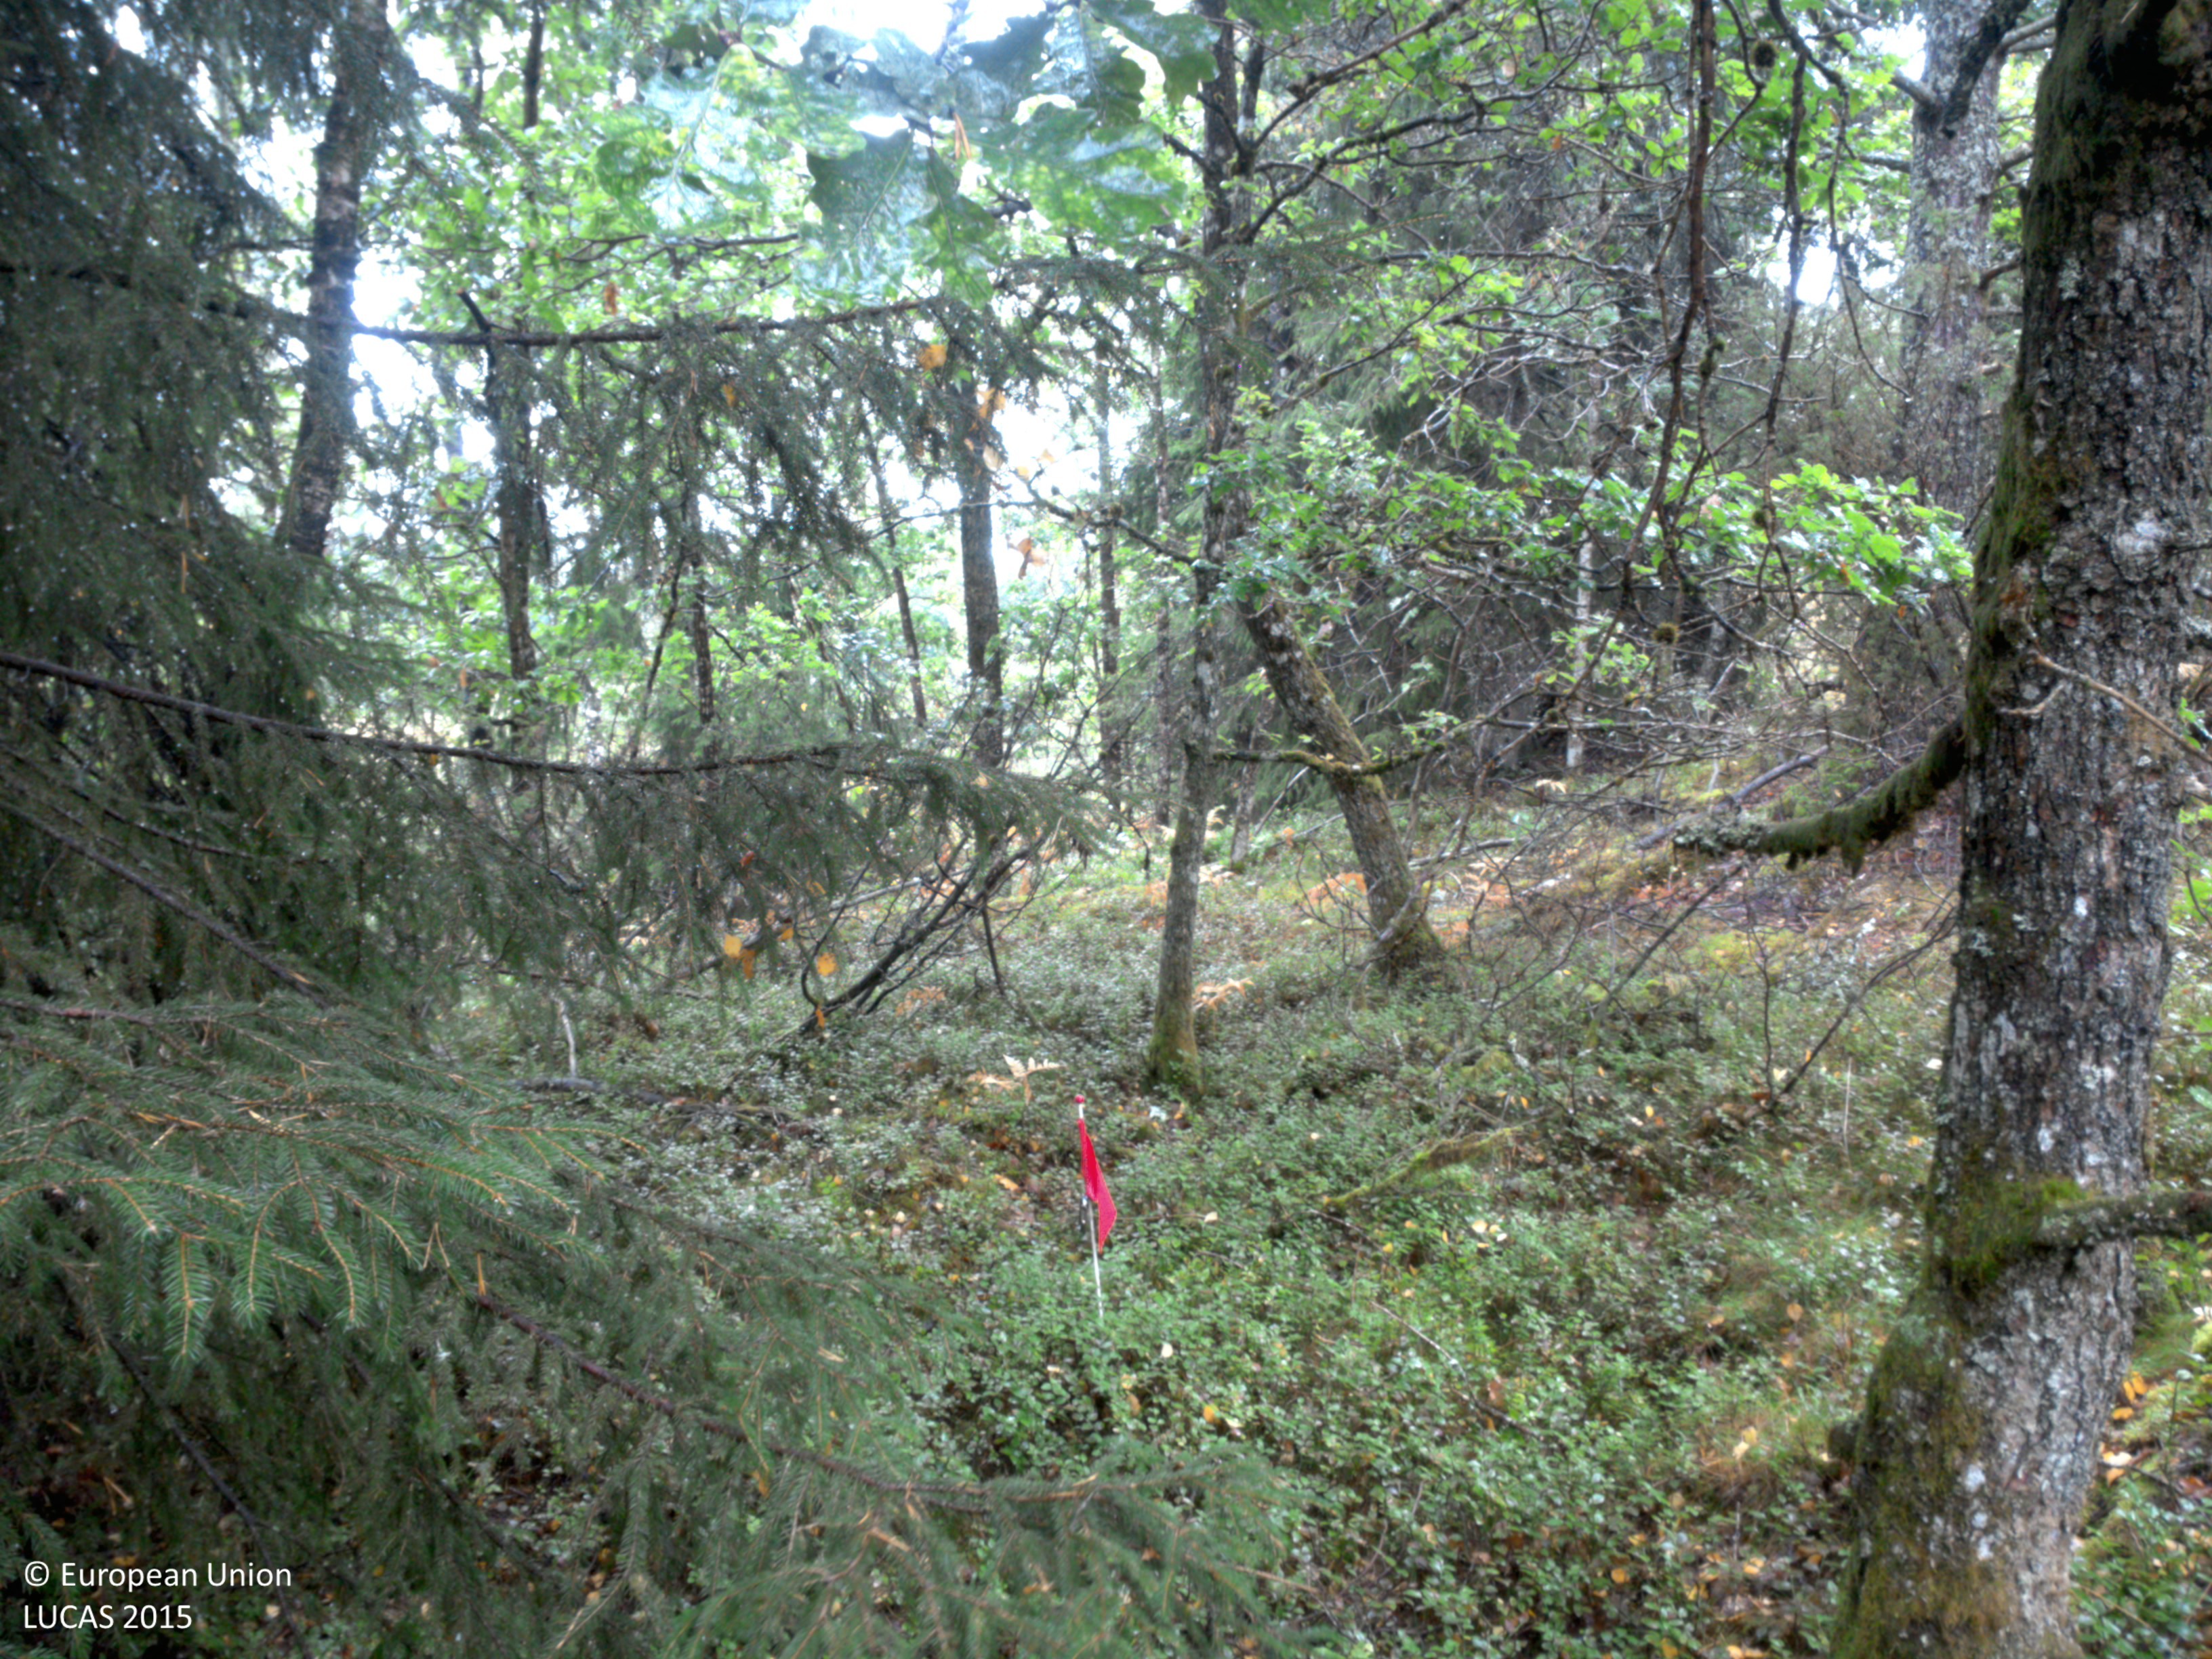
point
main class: Woodland
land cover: Other mixed woodland
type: boreal forest
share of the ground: 50 - 75 %
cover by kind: coniferous forest trees 30 %, broadleaved forest trees 30 %, herbaceous plants 30 %, lichens and mosses 10 %
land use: Forestry
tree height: > 5 m
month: August
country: SE
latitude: 58.1634
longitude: 12.3243
